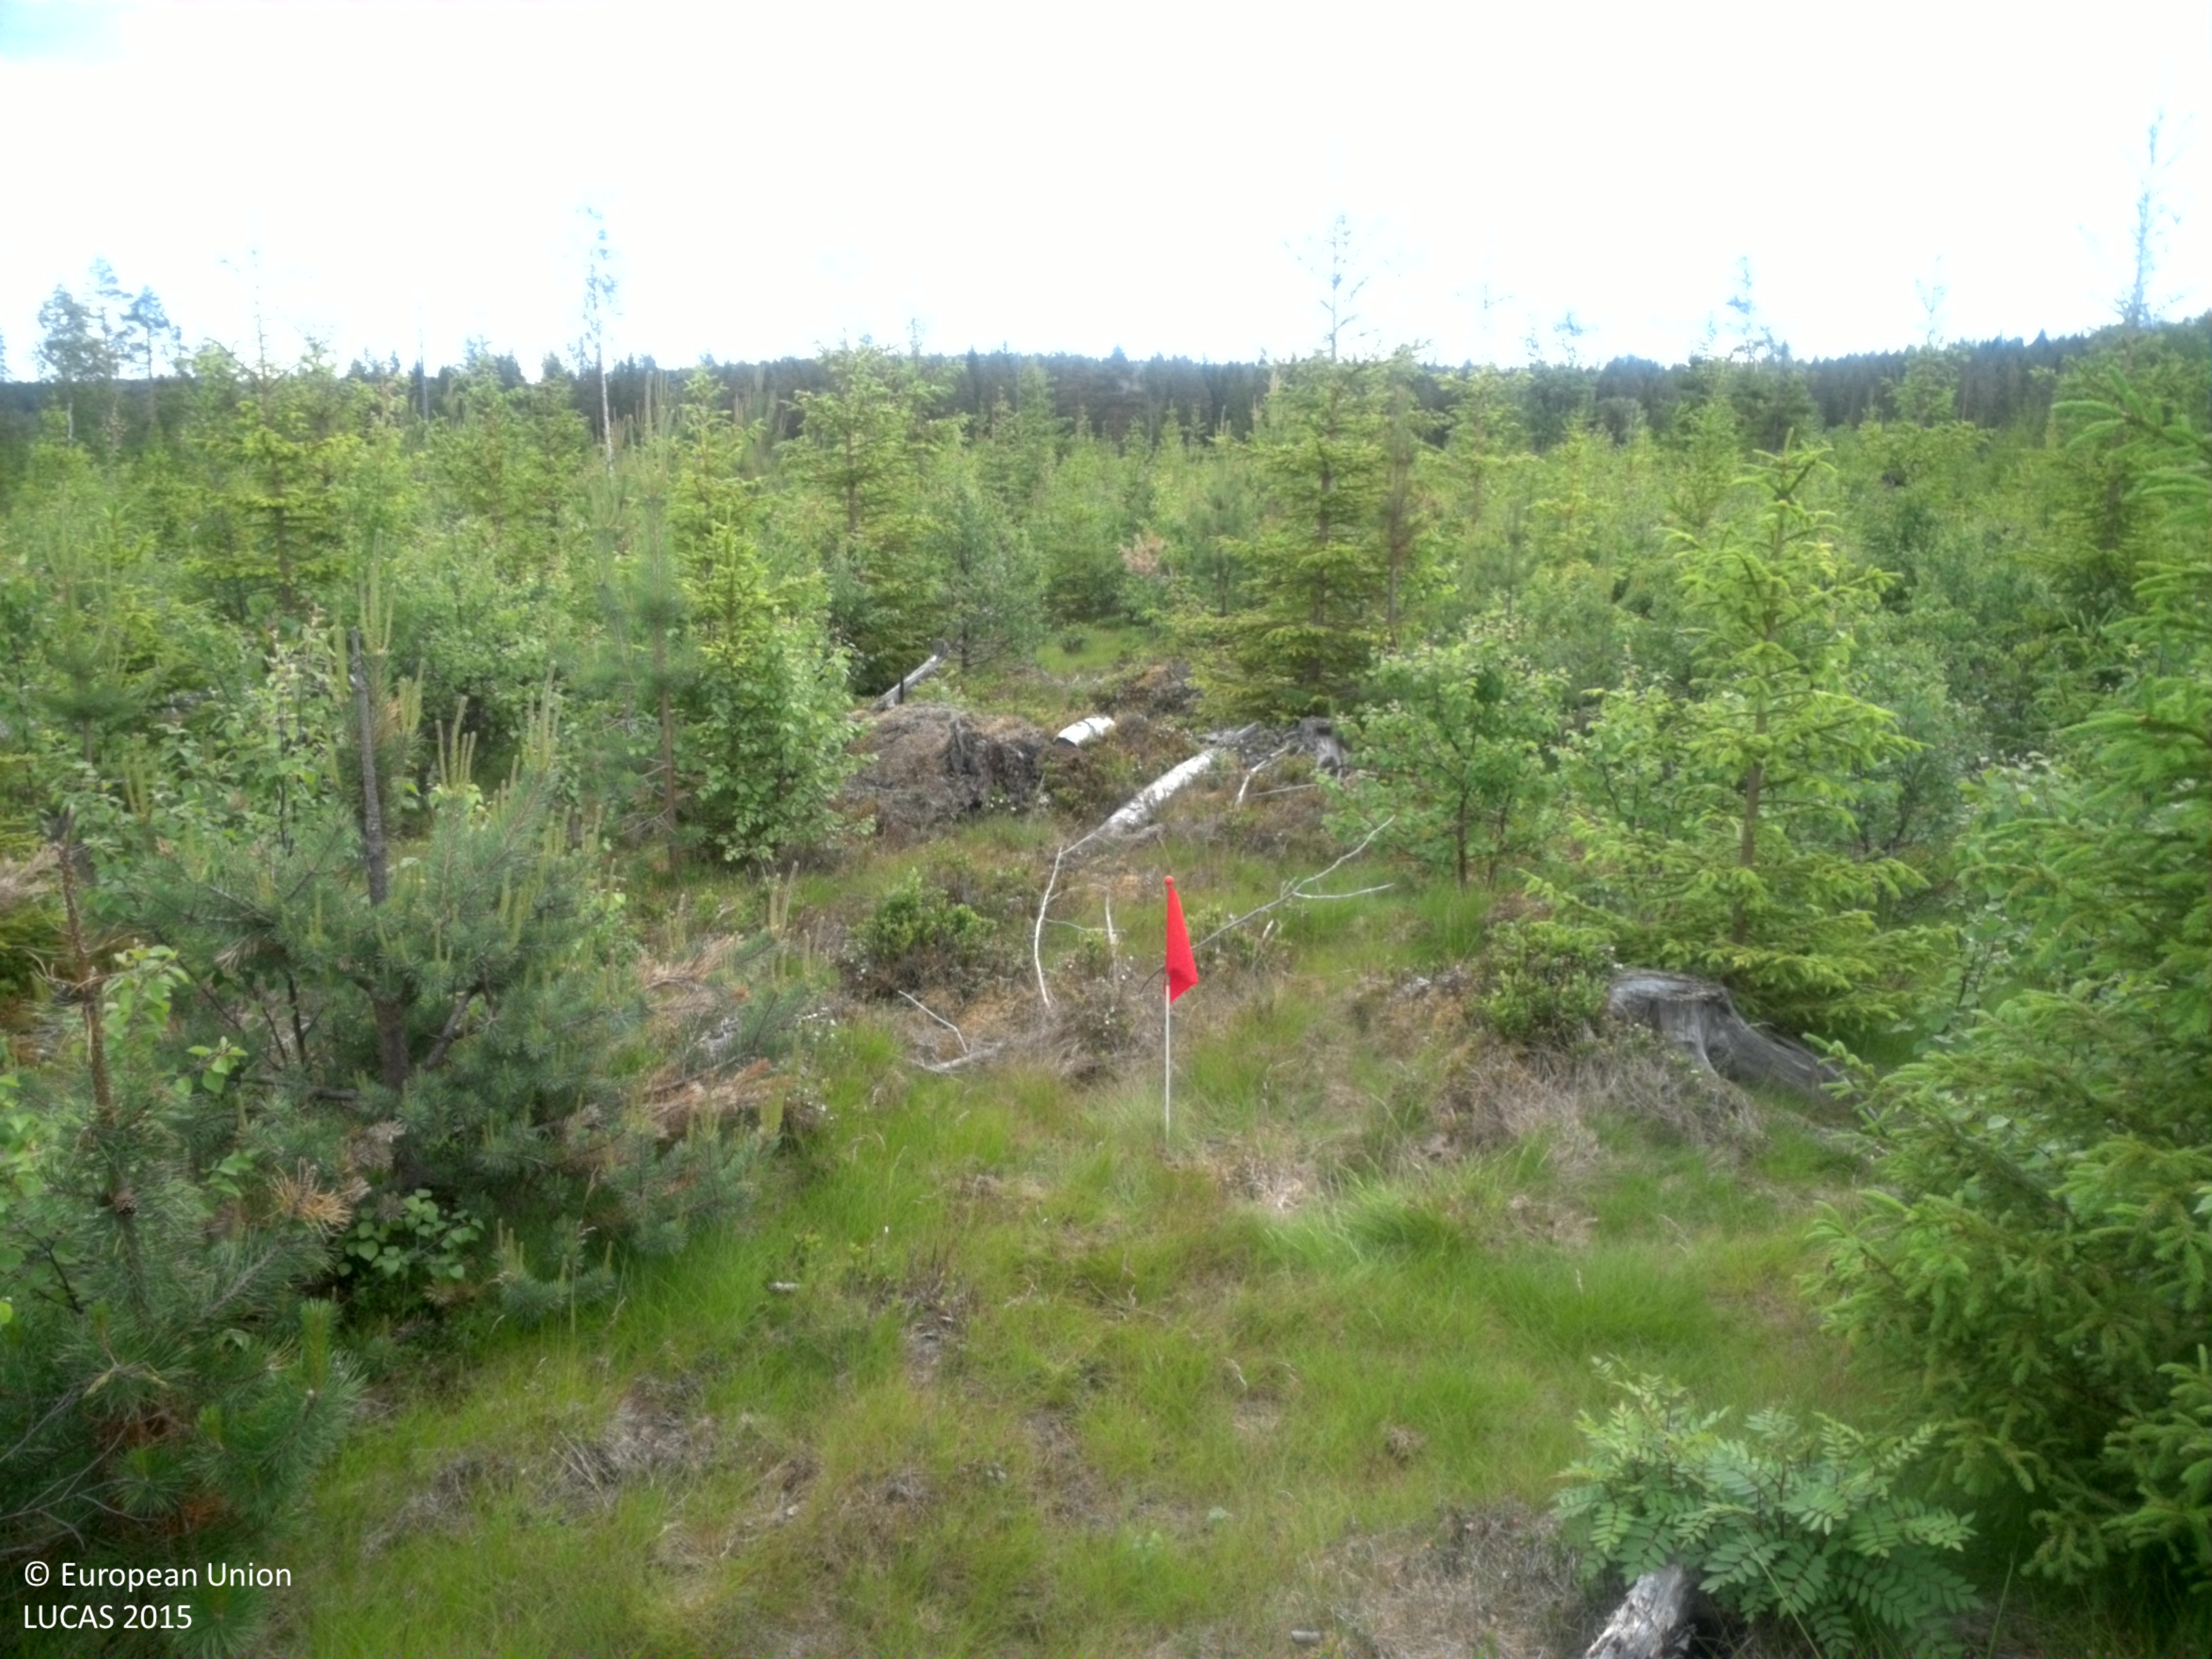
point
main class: Woodland
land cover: Other mixed woodland
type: boreal forest
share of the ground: > 75 %
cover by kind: coniferous forest trees 40 %, broadleaved forest trees 40 %, shrubs 10 %, herbaceous plants 10 %
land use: Forestry
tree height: < 5 m
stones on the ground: 25 - 50 %
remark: Clear cut
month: July
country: SE
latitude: 64.6262
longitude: 20.3277
